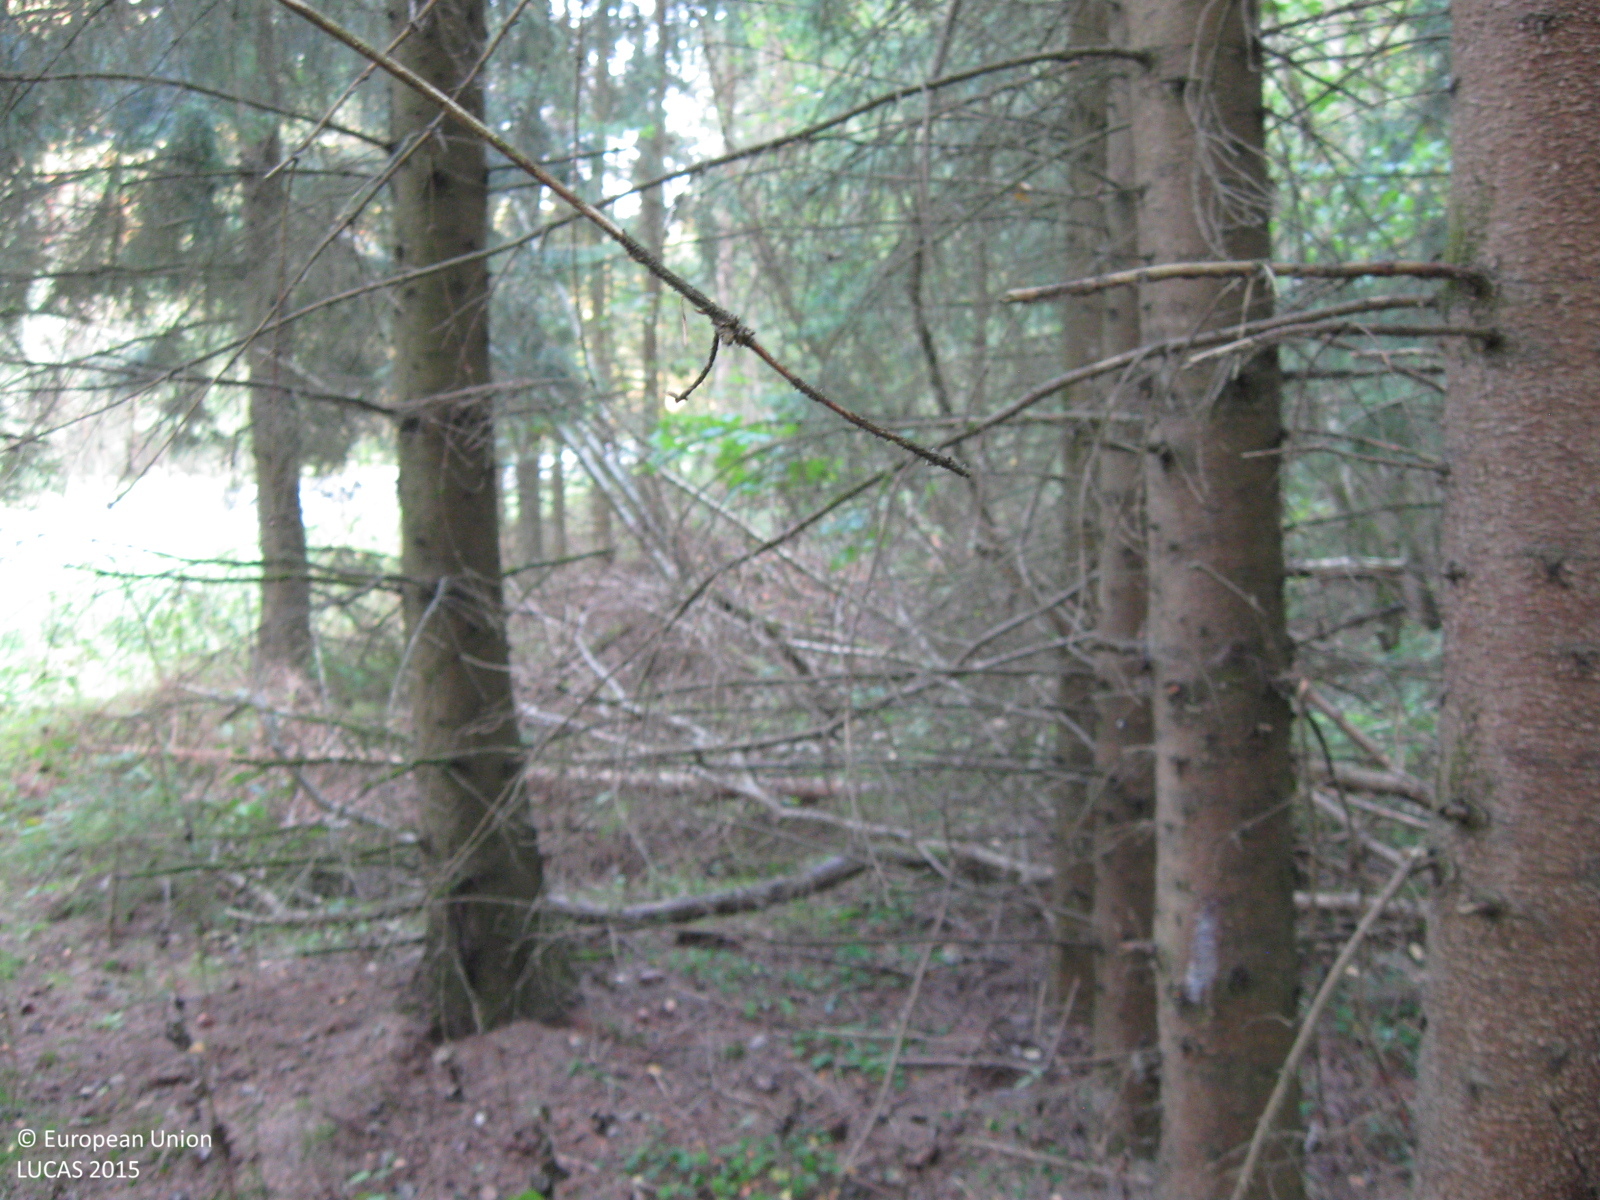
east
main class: Woodland
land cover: Spruce dominated mixed woodland
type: hemiboreal forest and nemoral coniferous forest and mixed broadleaved-coniferous forest
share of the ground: > 75 %
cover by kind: coniferous forest trees 55 %, broadleaved forest trees 35 %, herbaceous plants 10 %
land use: Forestry
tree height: > 5 m
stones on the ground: < 10 %
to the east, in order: Spruce dominated mixed woodland; Spontaneously vegetated surfaces; Paved roads, cycling and walking lanes; Spontaneously vegetated surfaces; Spruce dominated mixed woodland; Broadleaved woodland; Tracks; Broadleaved woodland
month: September
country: LT
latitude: 55.0837
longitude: 23.1866
